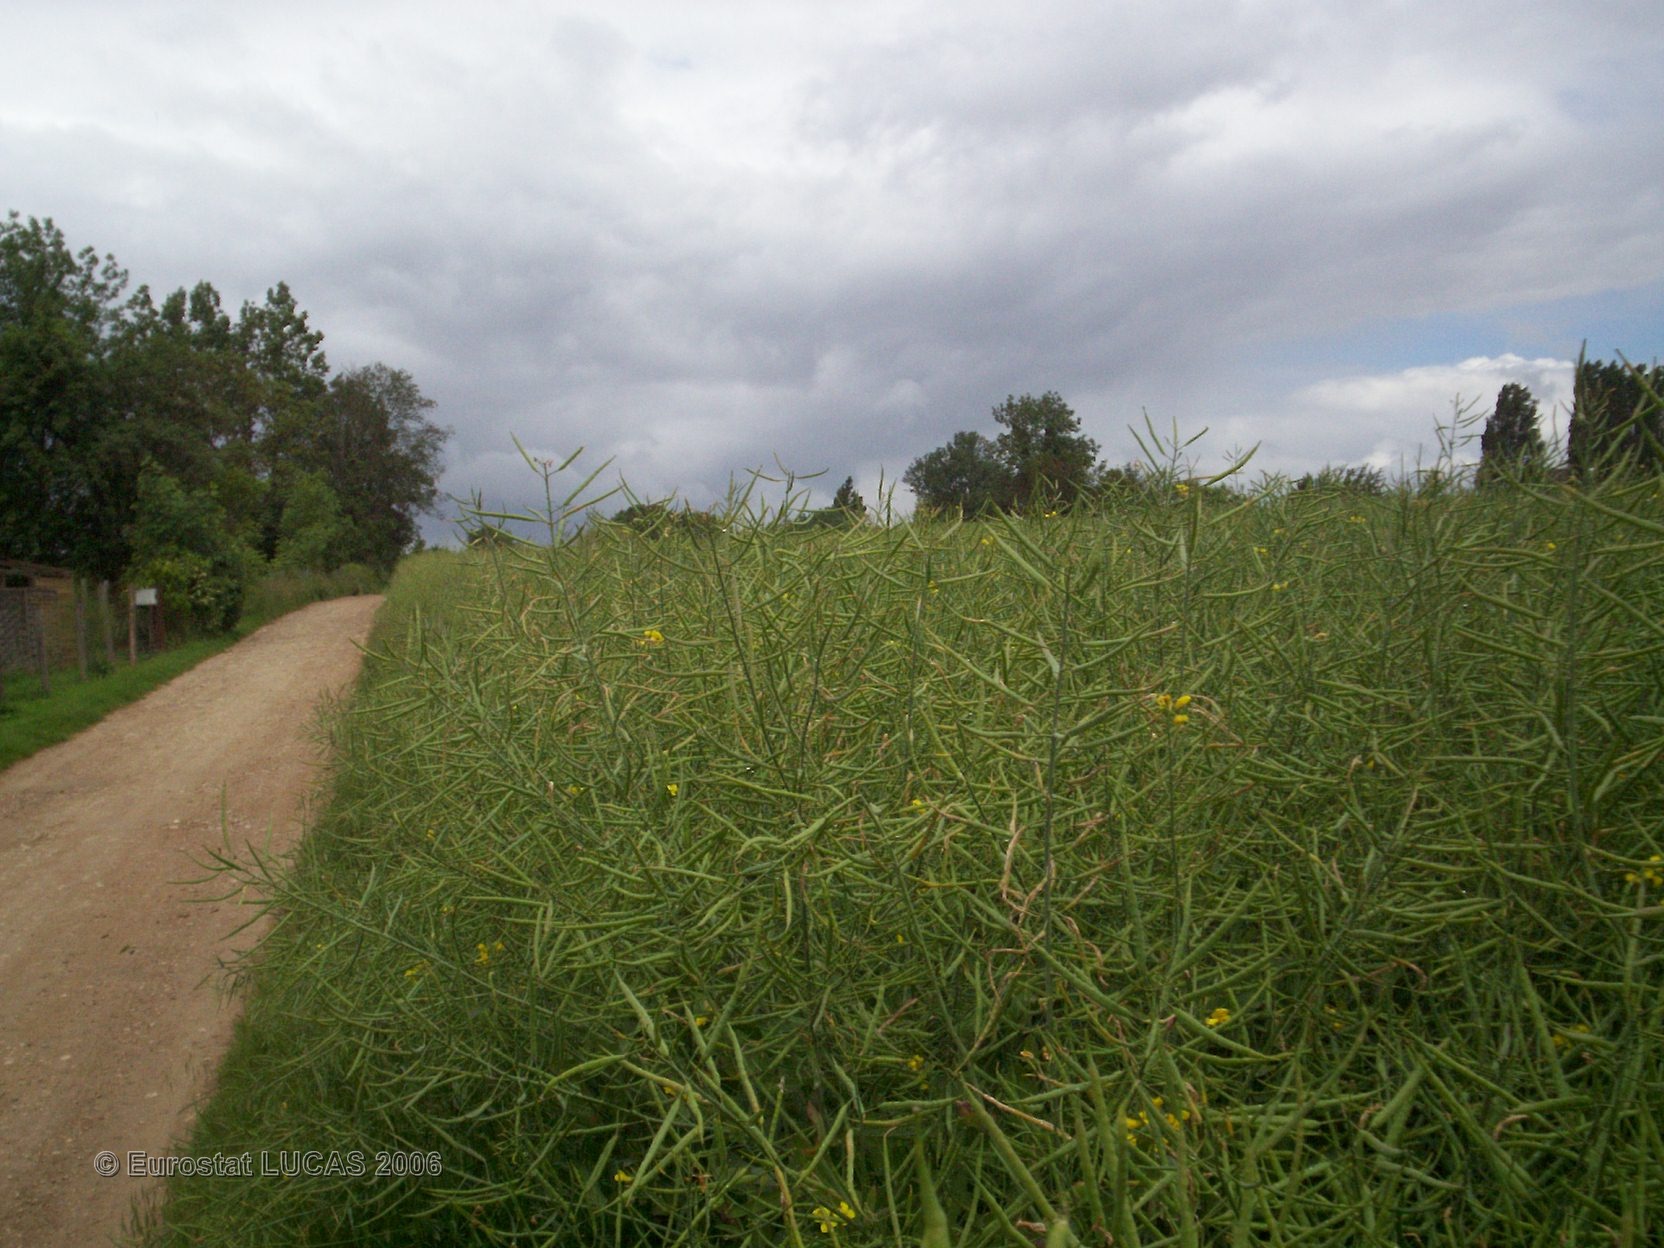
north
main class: Cropland
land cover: Rape and turnip rape
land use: Agriculture (excluding fallow land and kitchen gardens)
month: May
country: FR
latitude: 48.8948
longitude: 2.8568
